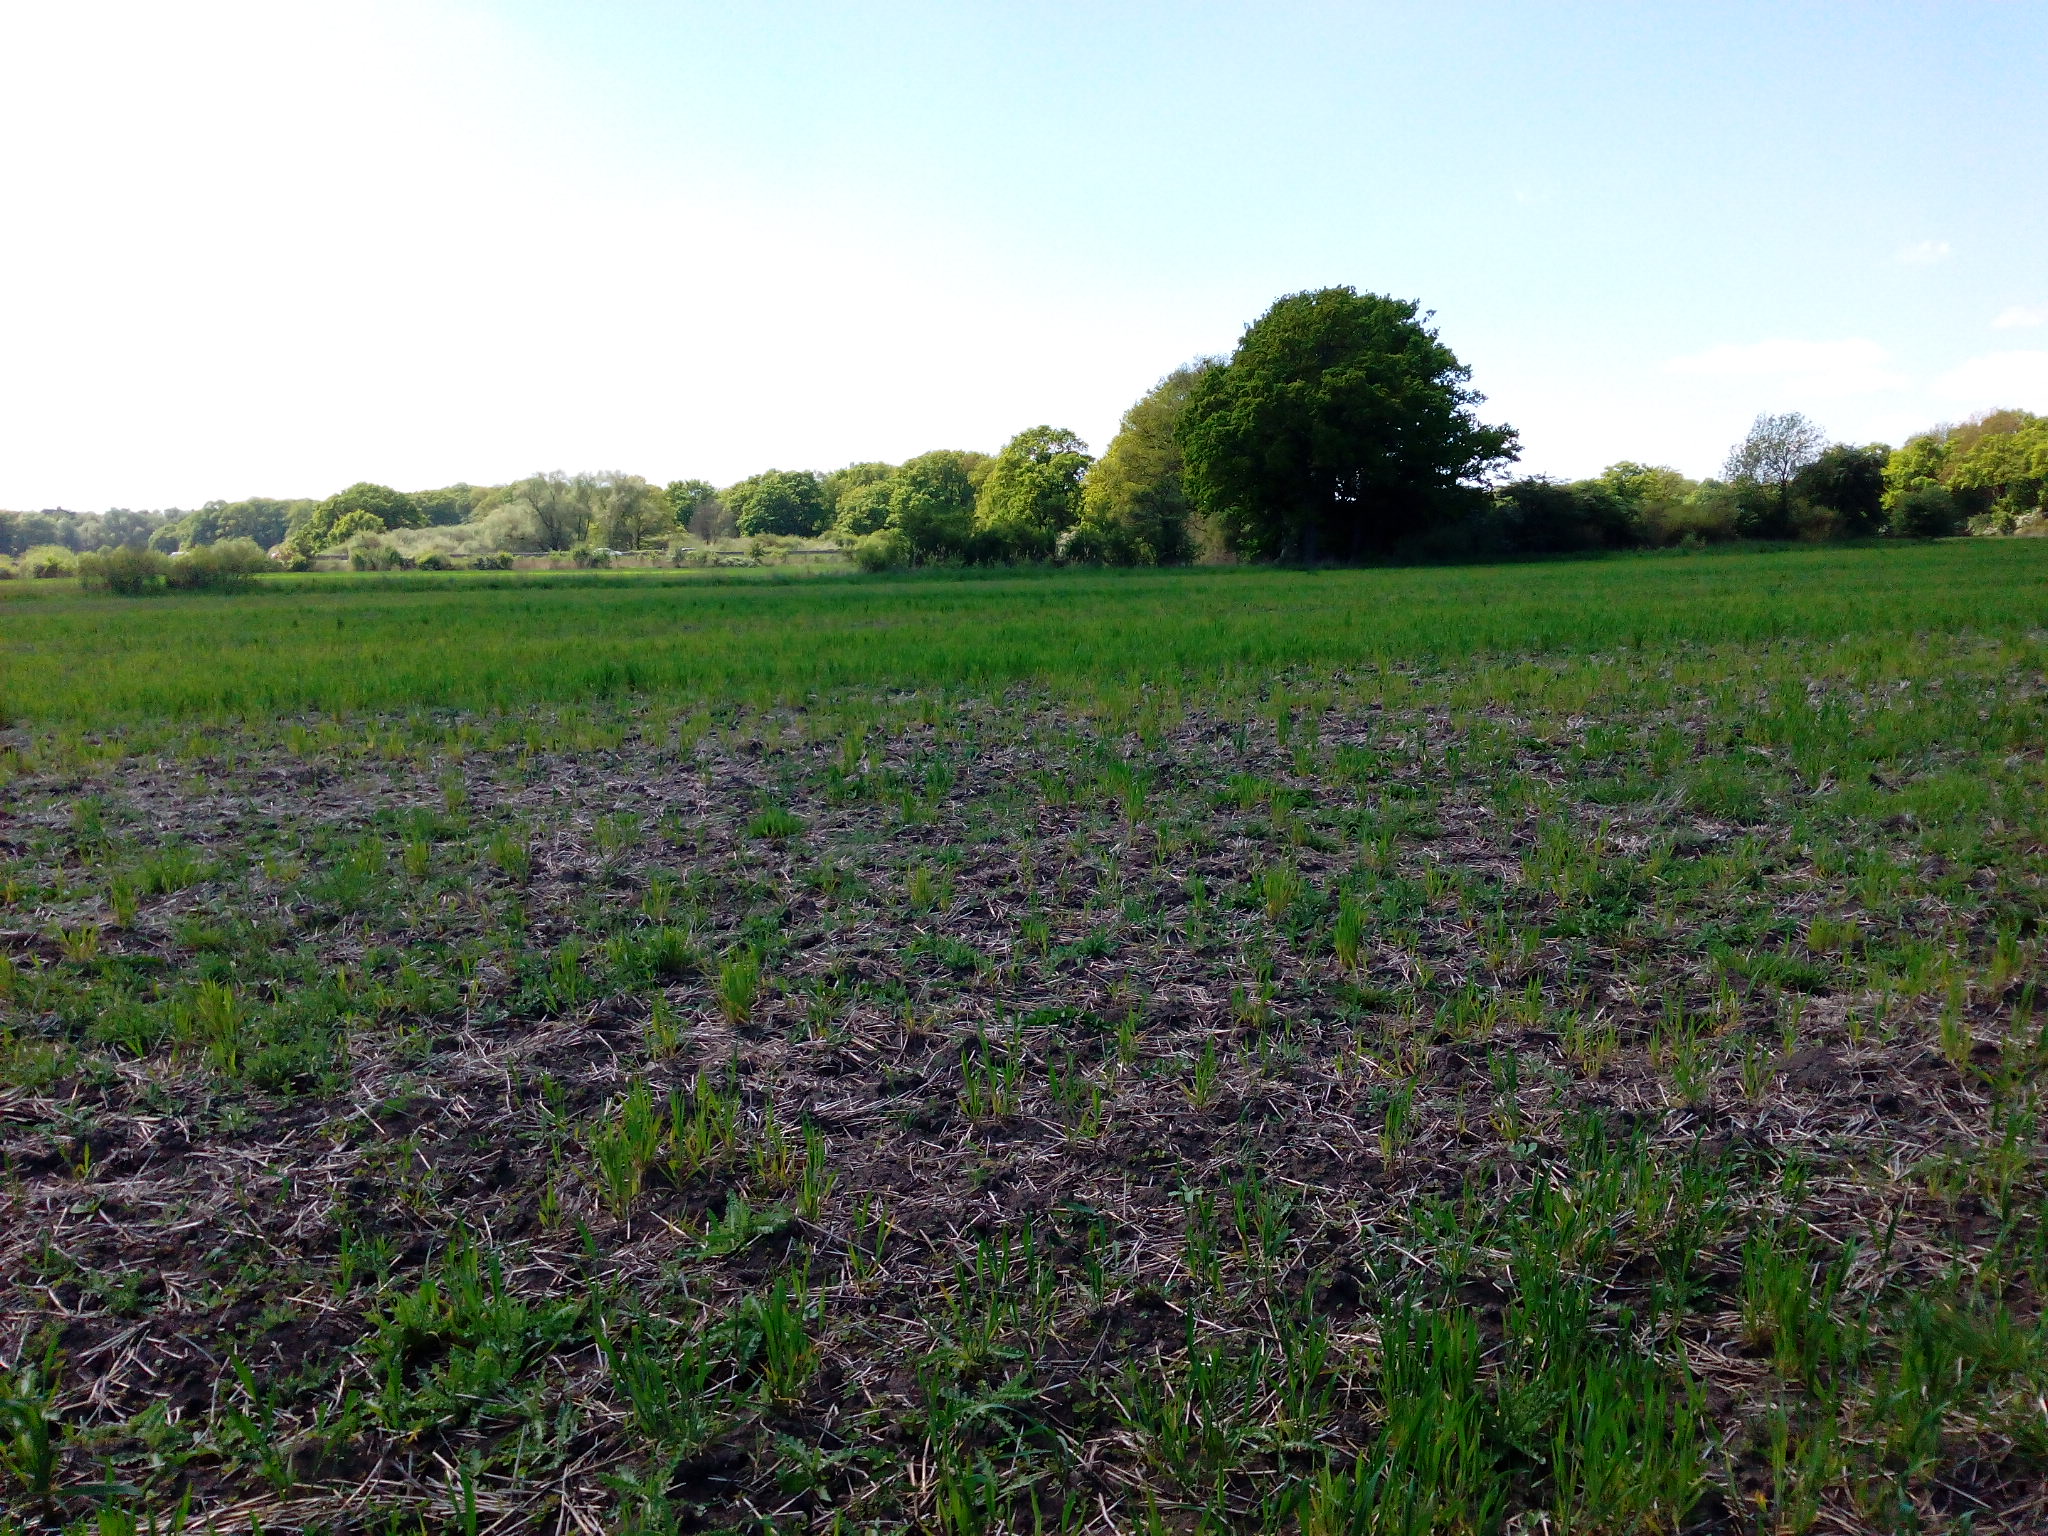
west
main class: Cropland
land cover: Triticale
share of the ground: < 10 %
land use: Agriculture (excluding fallow land and kitchen gardens)
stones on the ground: < 10 %
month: May
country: DE
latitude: 52.4493
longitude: 9.8676
